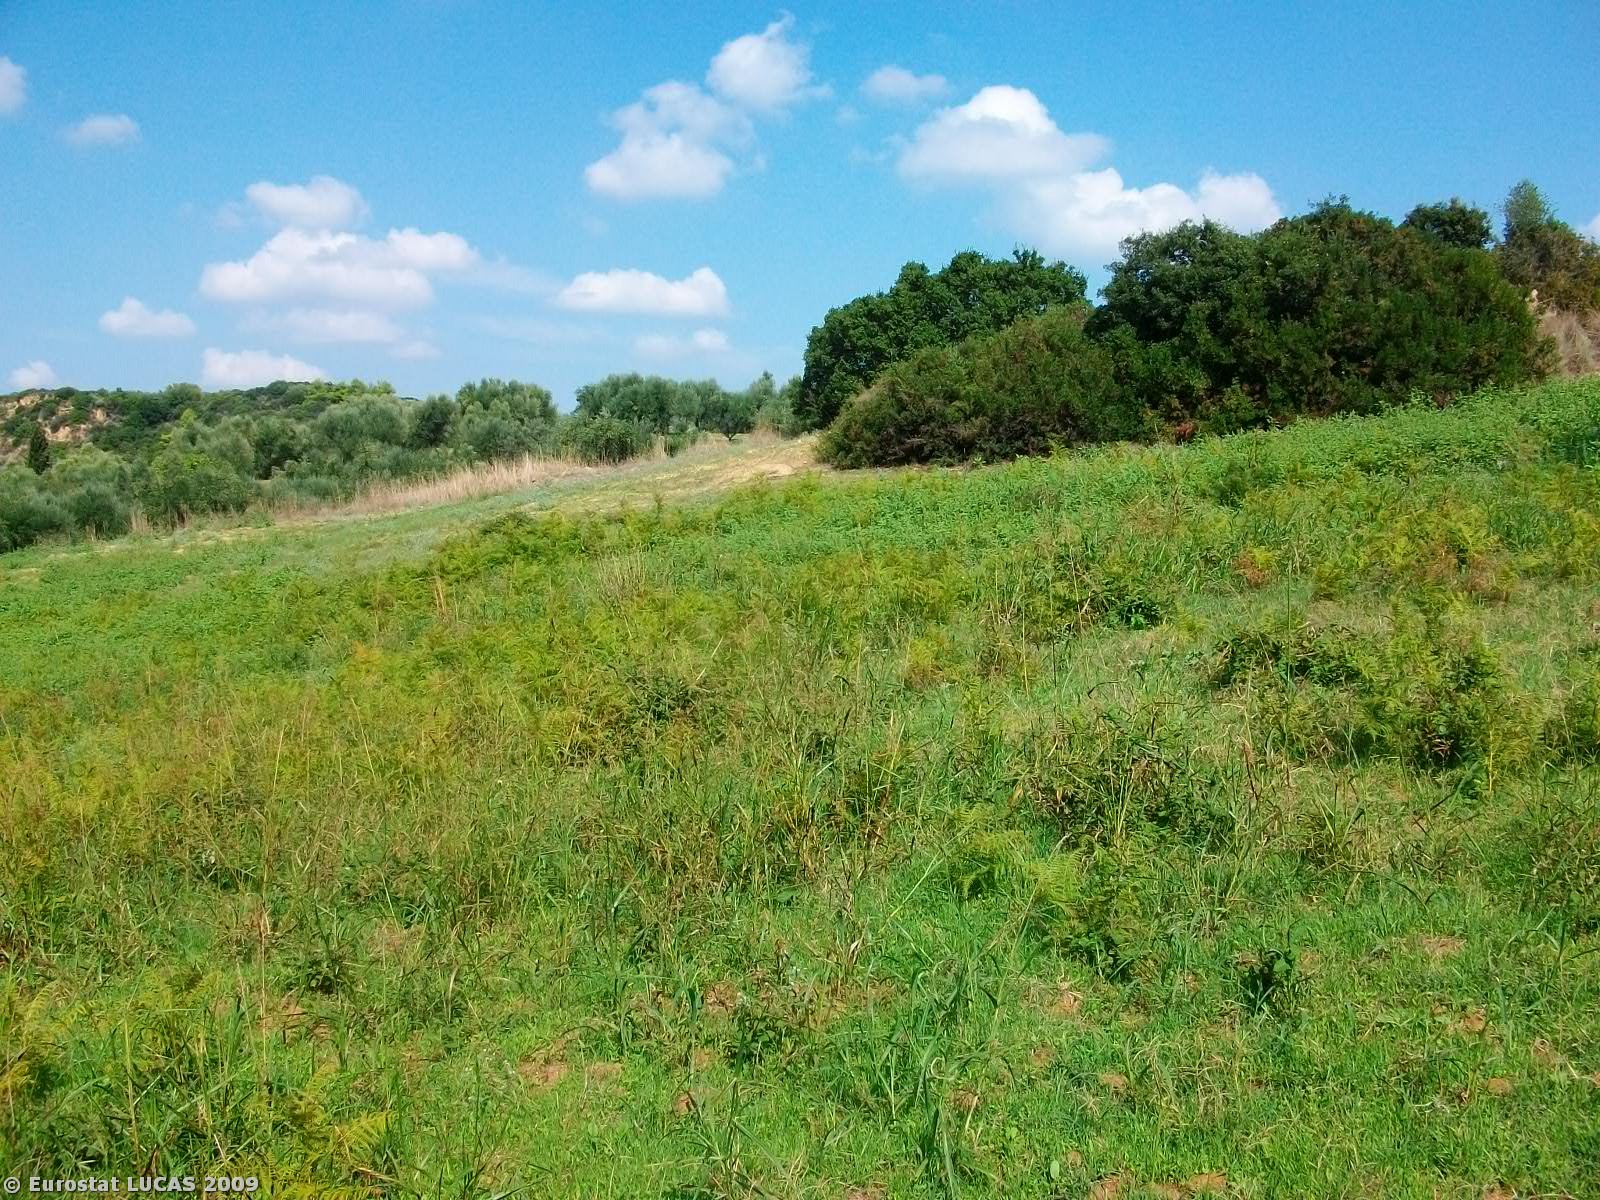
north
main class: Grassland
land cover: Grassland with sparse tree/shrub cover
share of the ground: > 75 %
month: September
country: GR
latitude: 37.7562
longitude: 21.3893
